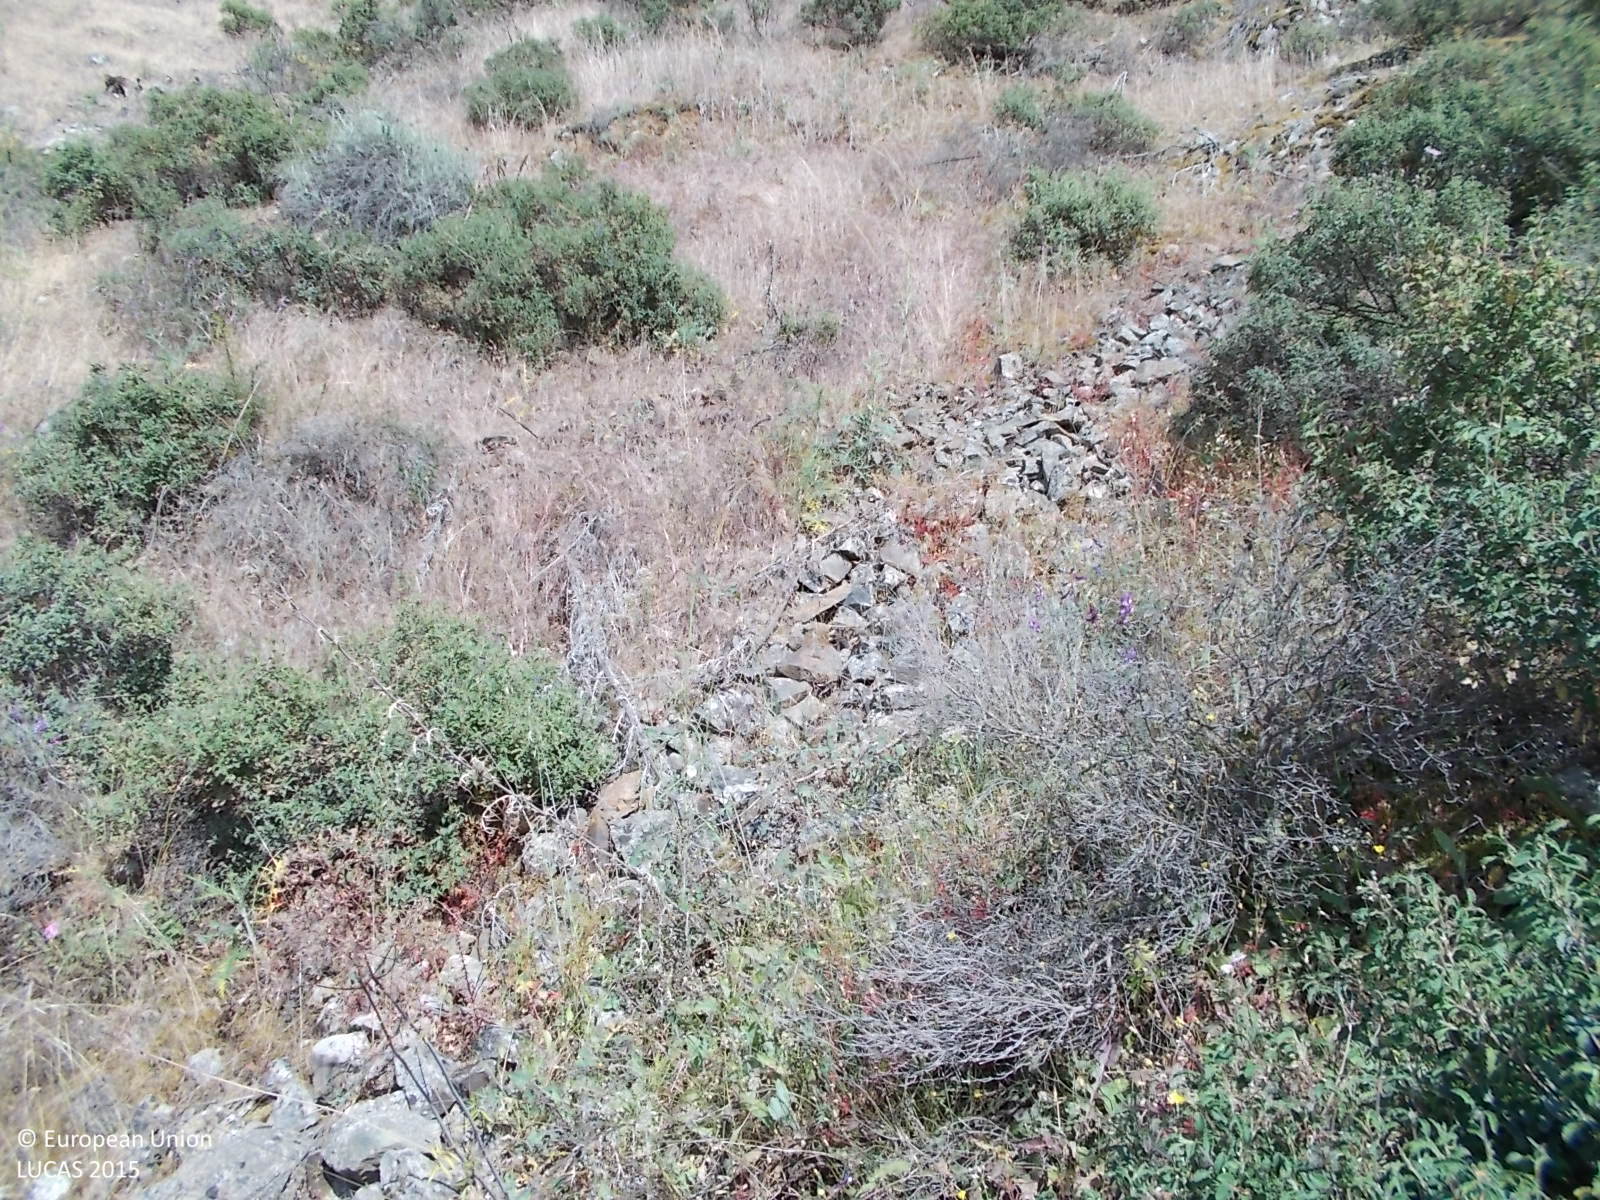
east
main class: Woodland
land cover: Pine dominated coniferous woodland
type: coniferous forest of the mediterranean region
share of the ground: 10 - 25 %
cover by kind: shrubs 40 %, herbaceous plants 35 %, coniferous forest trees 15 %, unconsolidated bare surface 10 %
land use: Forestry
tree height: > 5 m
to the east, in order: Pine dominated coniferous woodland
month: May
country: CY
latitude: 34.9795
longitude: 33.0812
